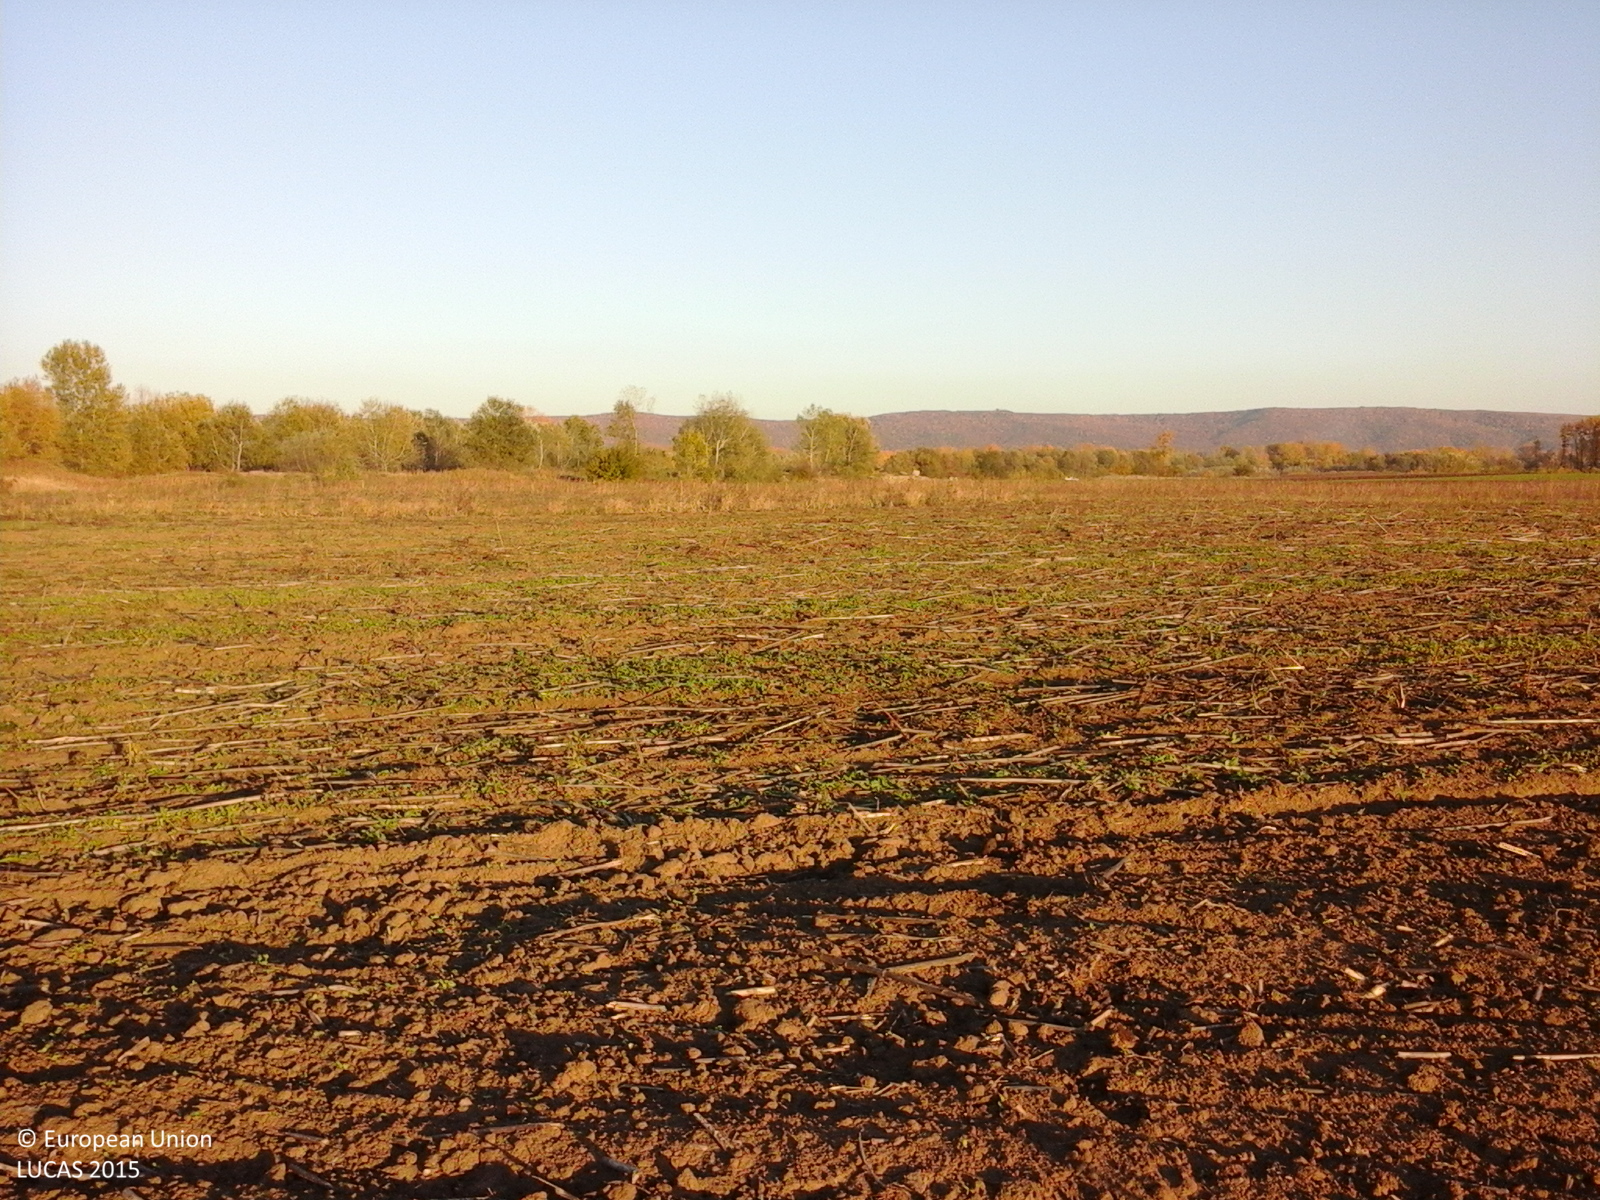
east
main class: Cropland
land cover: Sunflower
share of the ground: < 10 %
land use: Agriculture (excluding fallow land and kitchen gardens)
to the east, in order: Sunflower; Spontaneously vegetated surfaces; Tracks; Spontaneously vegetated surfaces; Other bare soil; Lucerne; Grass margins; Tracks; Grass margins; Grassland with sparse tree/shrub cover
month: October
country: RO
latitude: 46.1014
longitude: 27.2134
